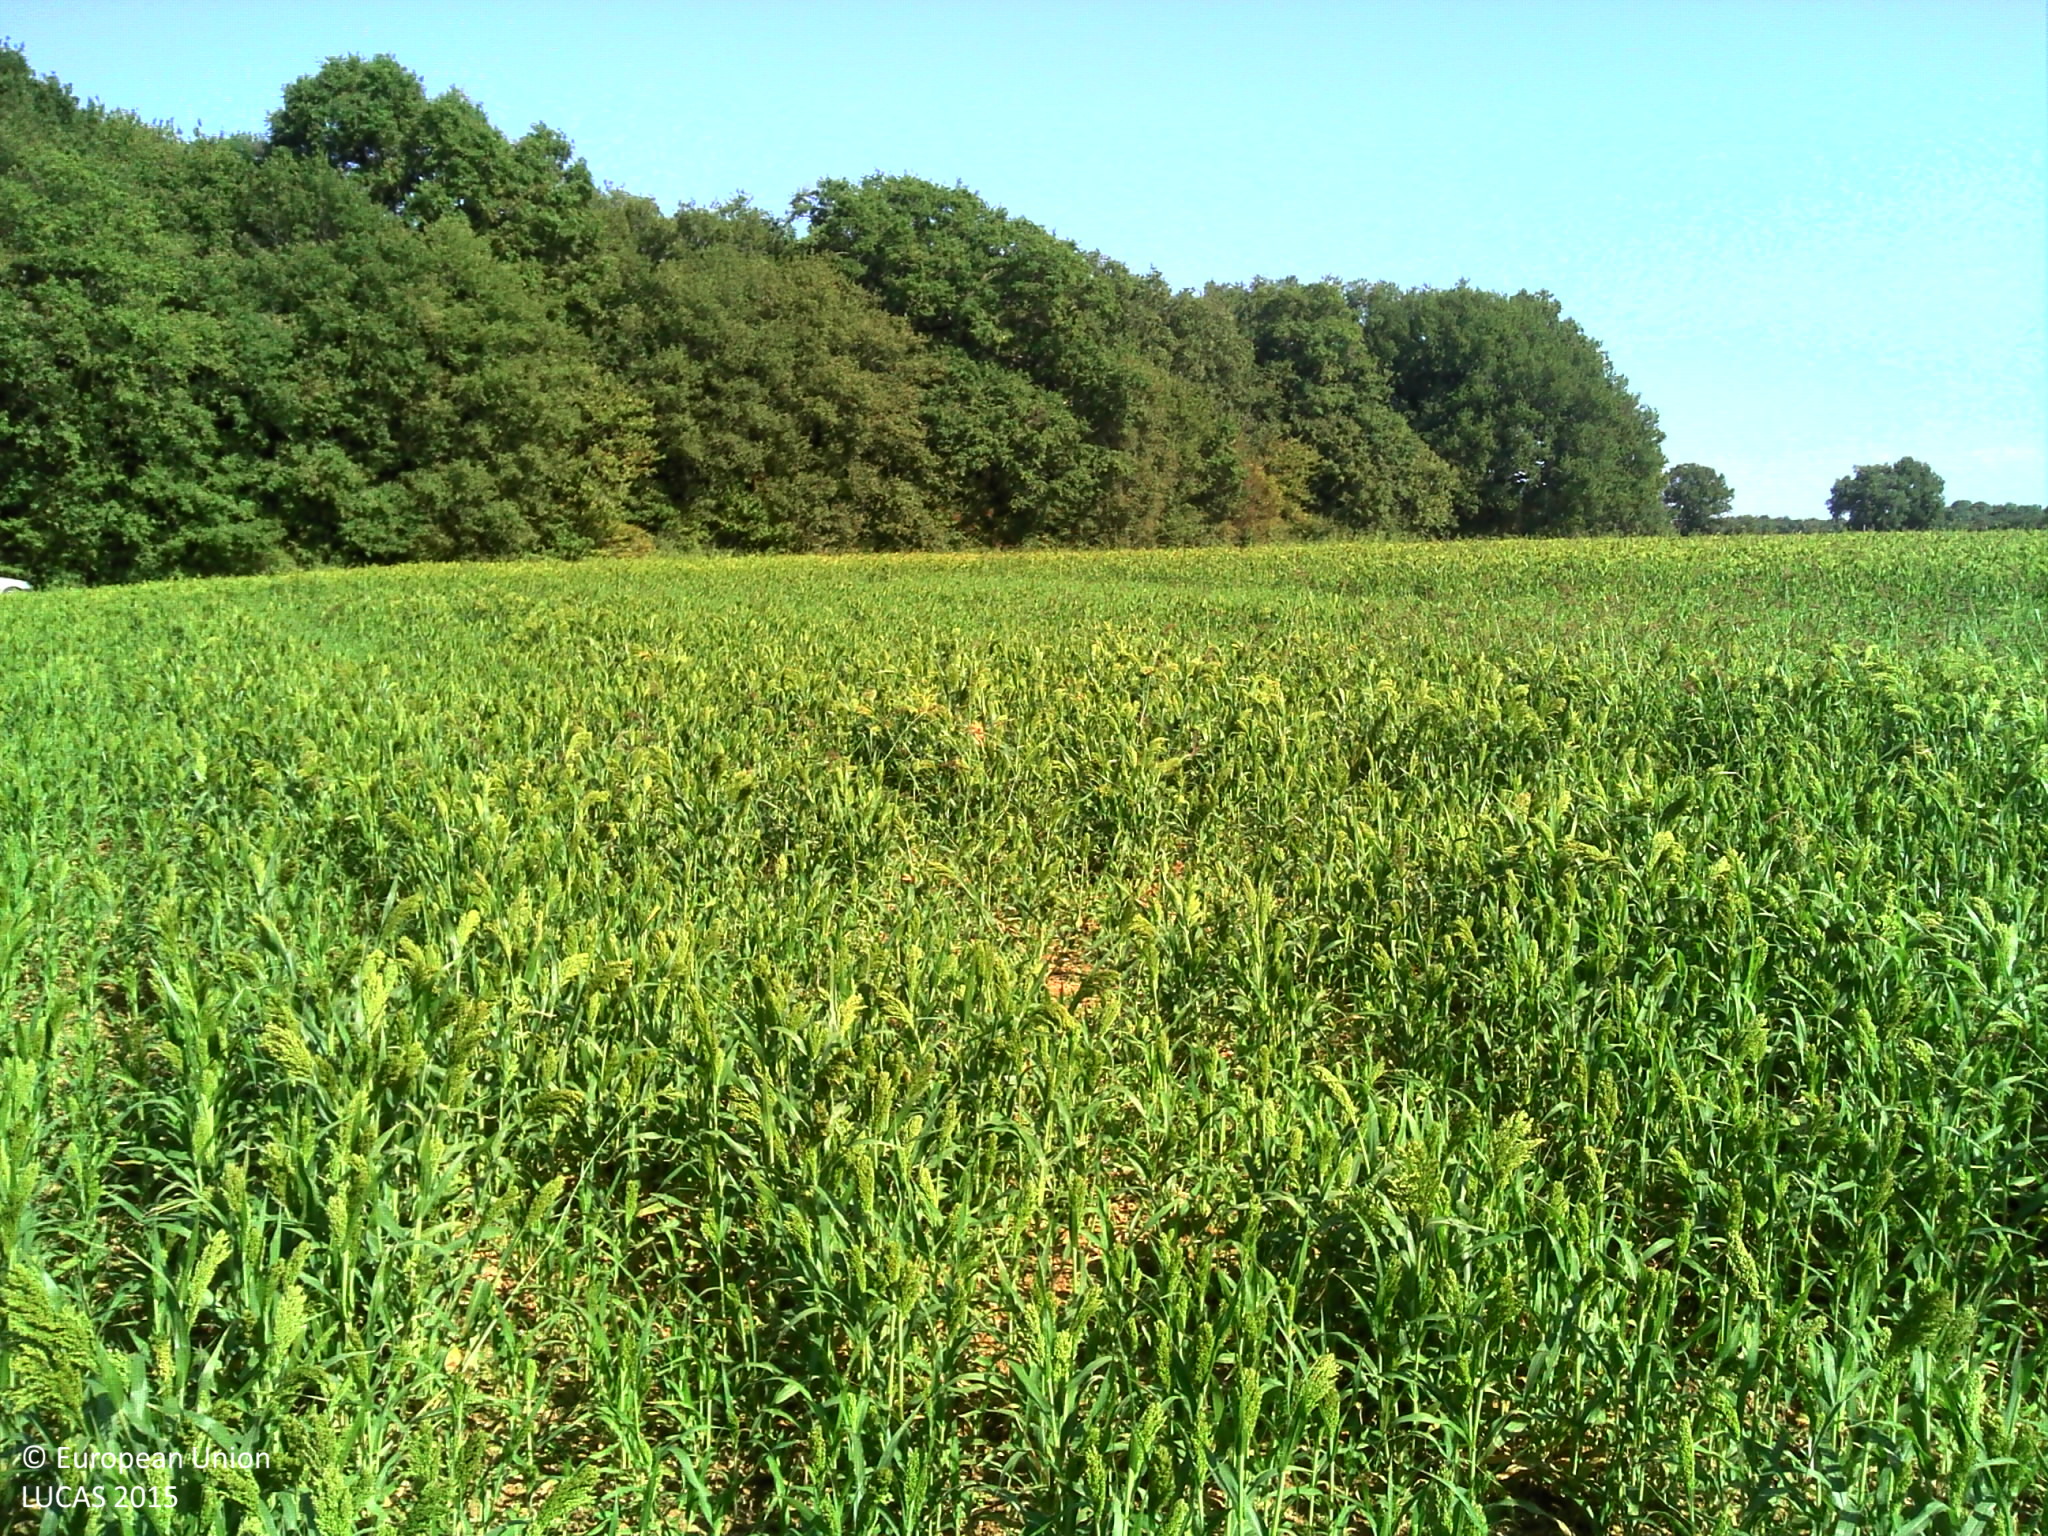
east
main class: Cropland
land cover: Other cereals
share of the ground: > 75 %
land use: Agriculture (excluding fallow land and kitchen gardens)
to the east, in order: Other cereals; Grass margins; Tracks; Grass margins; Ditches and canals; Broadleaved woodland; Ditches and canals; Grass margins; Other bare soil
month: September
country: FR
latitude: 46.9746
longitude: 1.0860
